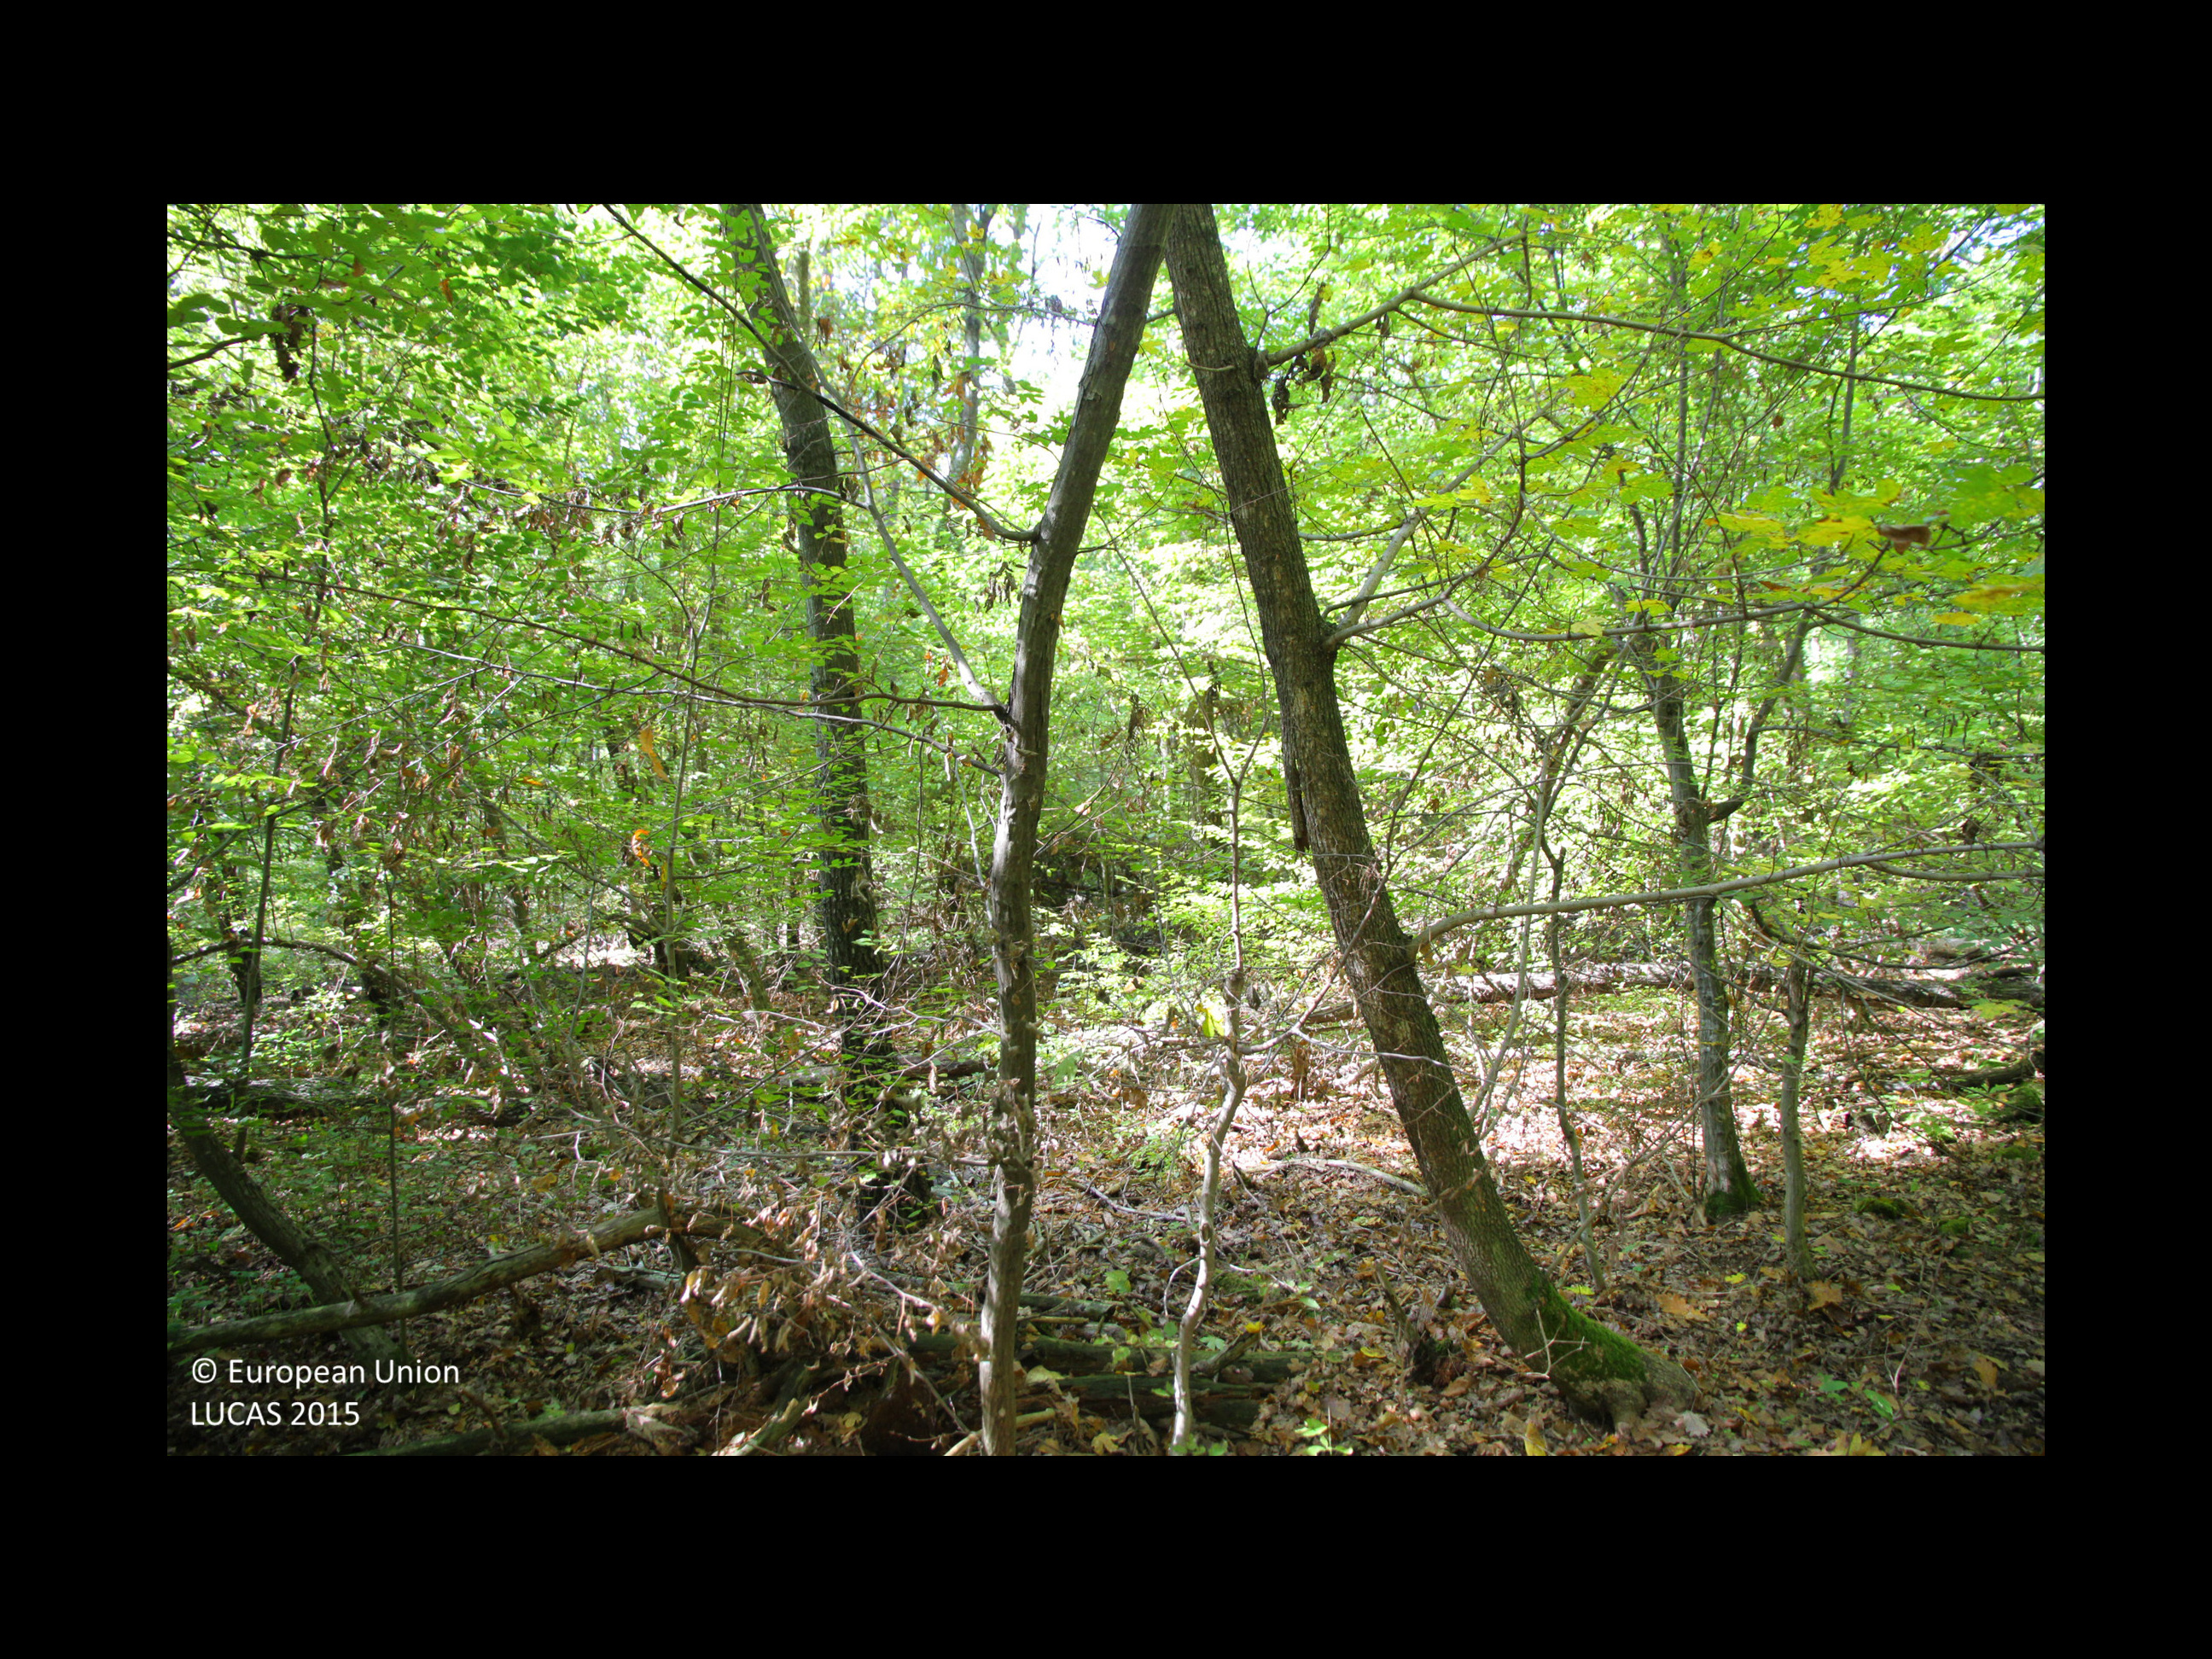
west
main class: Woodland
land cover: Broadleaved woodland
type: mesophytic deciduous forest
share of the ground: > 75 %
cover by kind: broadleaved forest trees 100 %
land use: Forestry
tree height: > 5 m
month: October
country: BG
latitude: 43.0202
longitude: 26.9329
